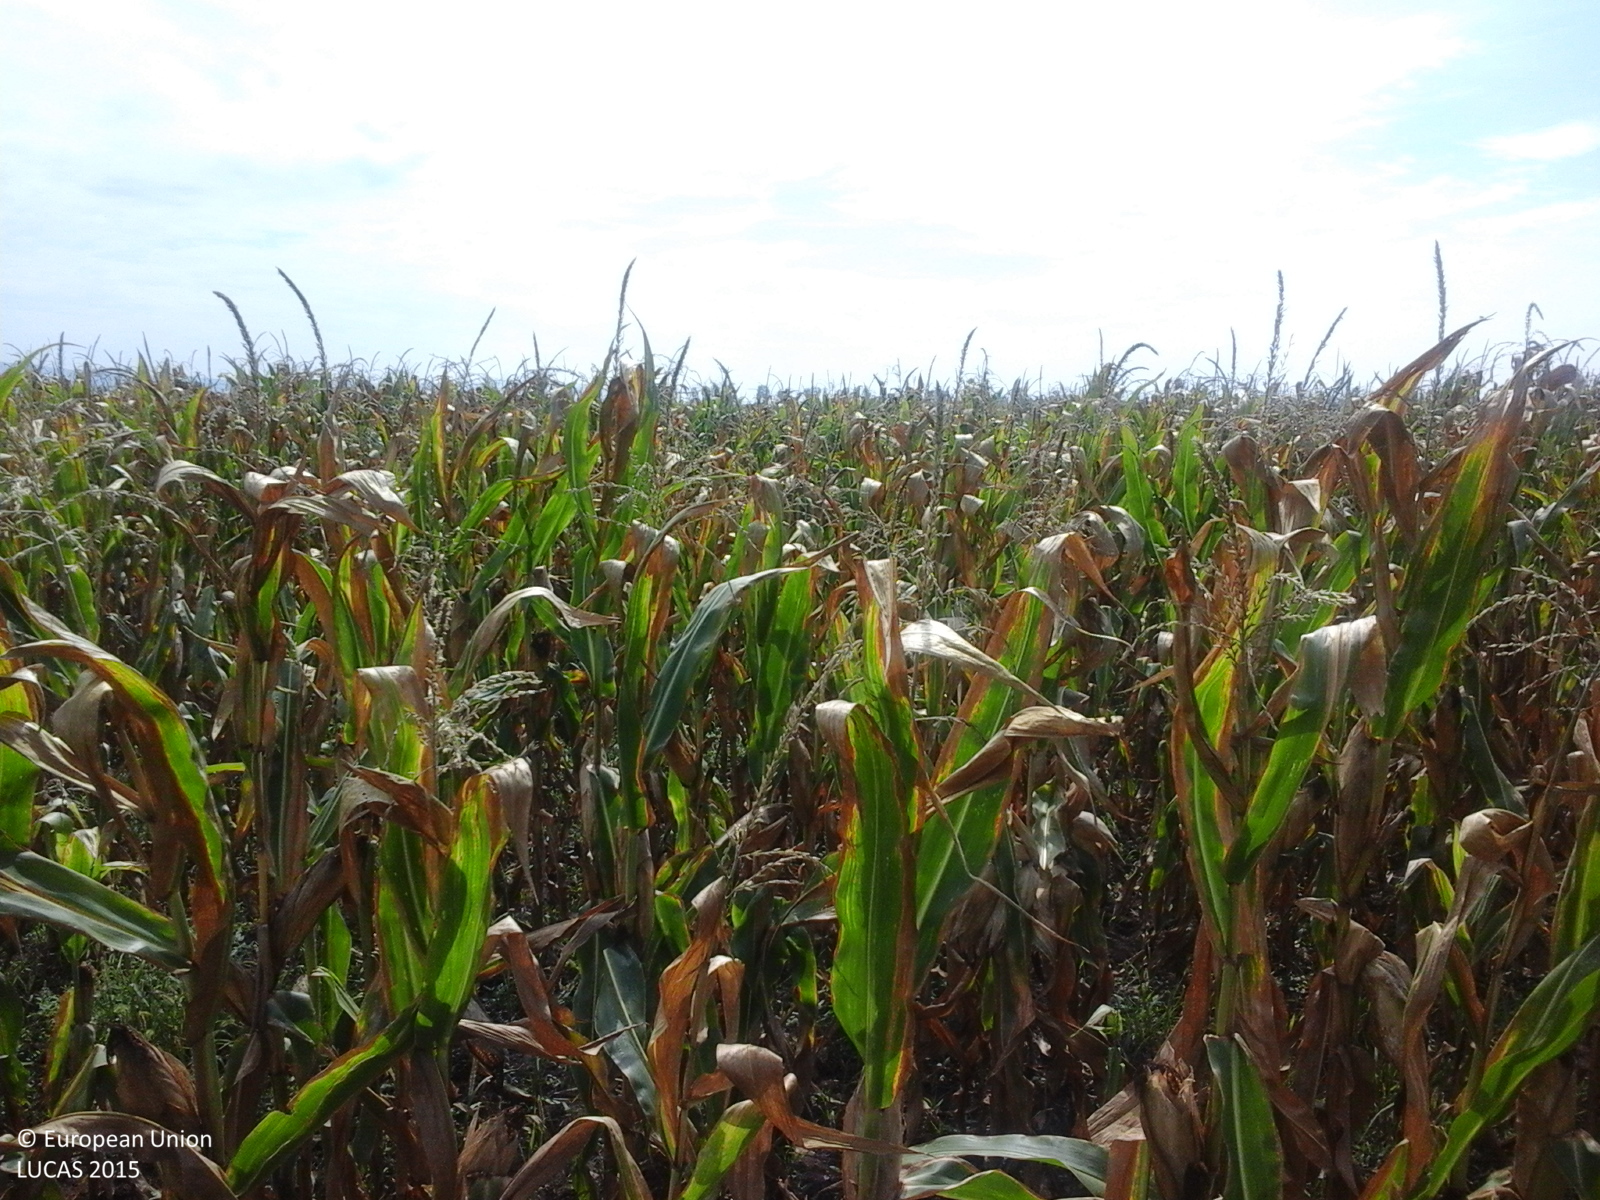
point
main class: Cropland
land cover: Maize
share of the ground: > 75 %
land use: Agriculture (excluding fallow land and kitchen gardens)
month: August
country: RO
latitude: 46.3814
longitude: 21.5182
